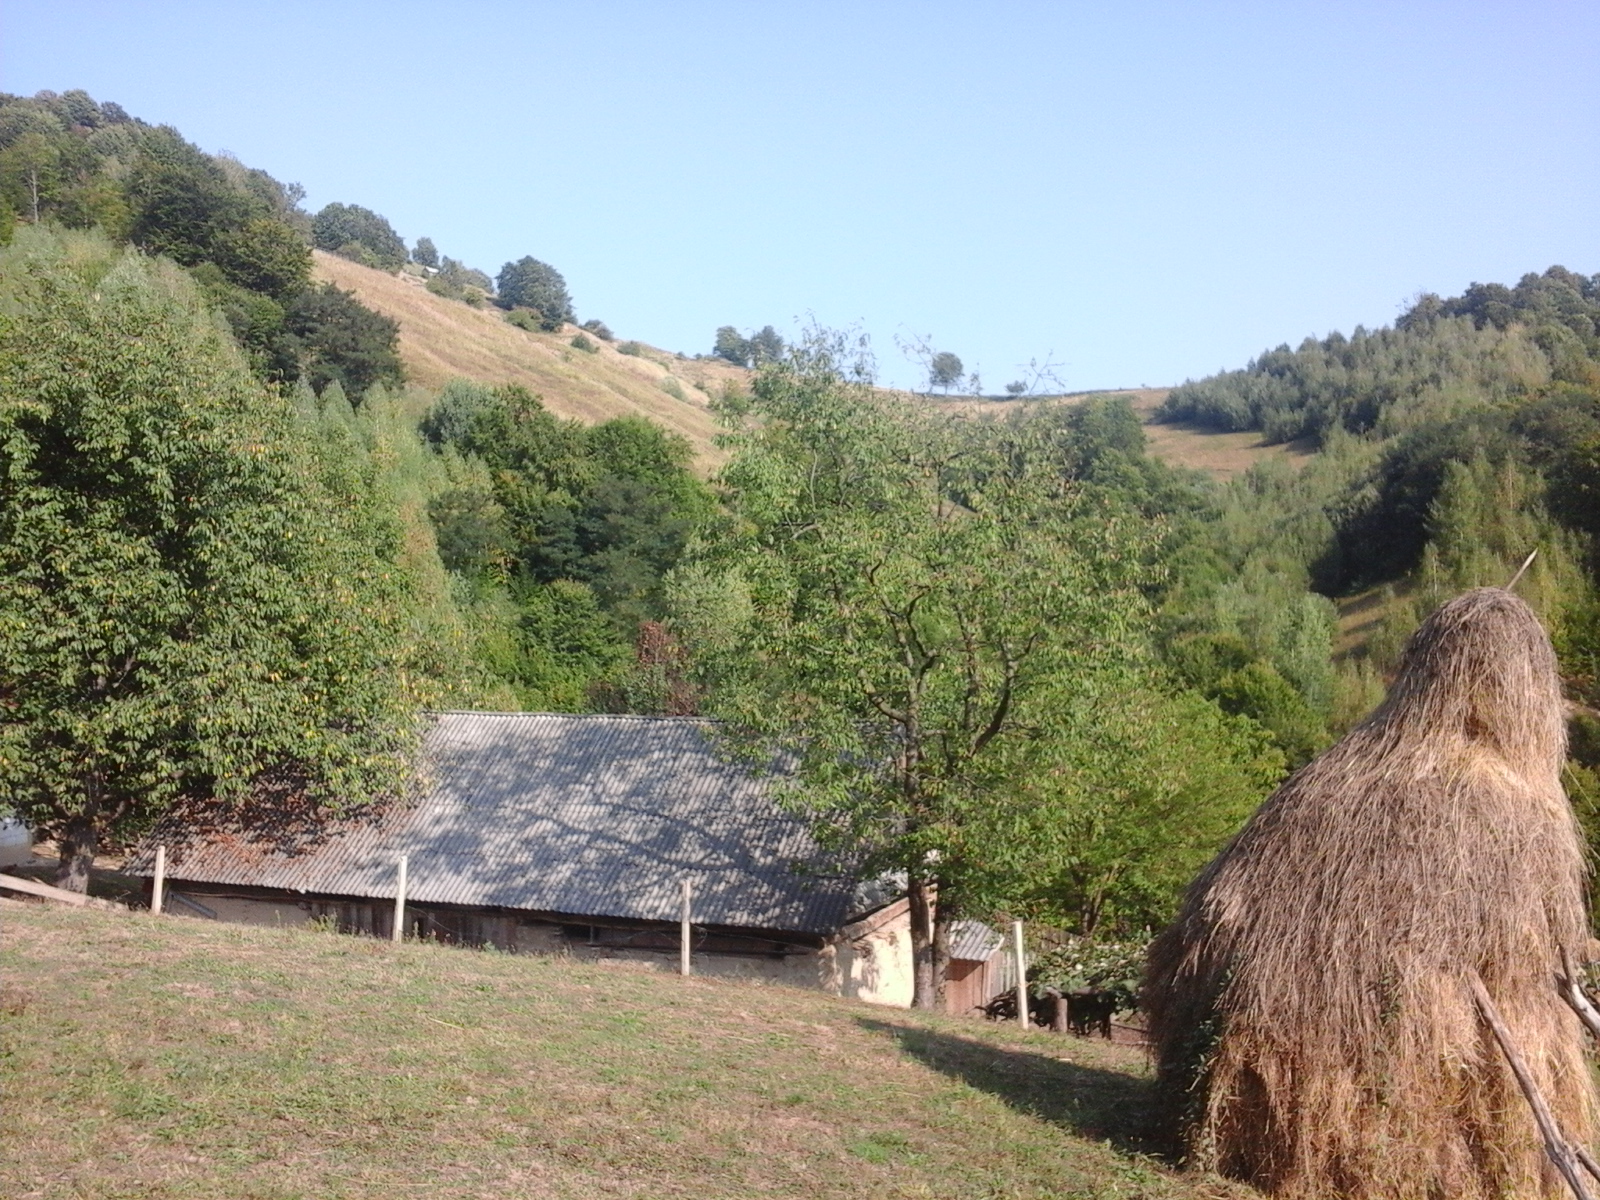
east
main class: Grassland
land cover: Grassland without tree/shrub cover
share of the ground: > 75 %
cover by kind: herbaceous plants 100 %
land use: Agriculture (excluding fallow land and kitchen gardens)
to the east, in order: Grassland without tree/shrub cover; Artificial constructions in urban areas; Grassland without tree/shrub cover; Broadleaved woodland; Grassland without tree/shrub cover
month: September
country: RO
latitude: 47.3904
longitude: 24.1953
